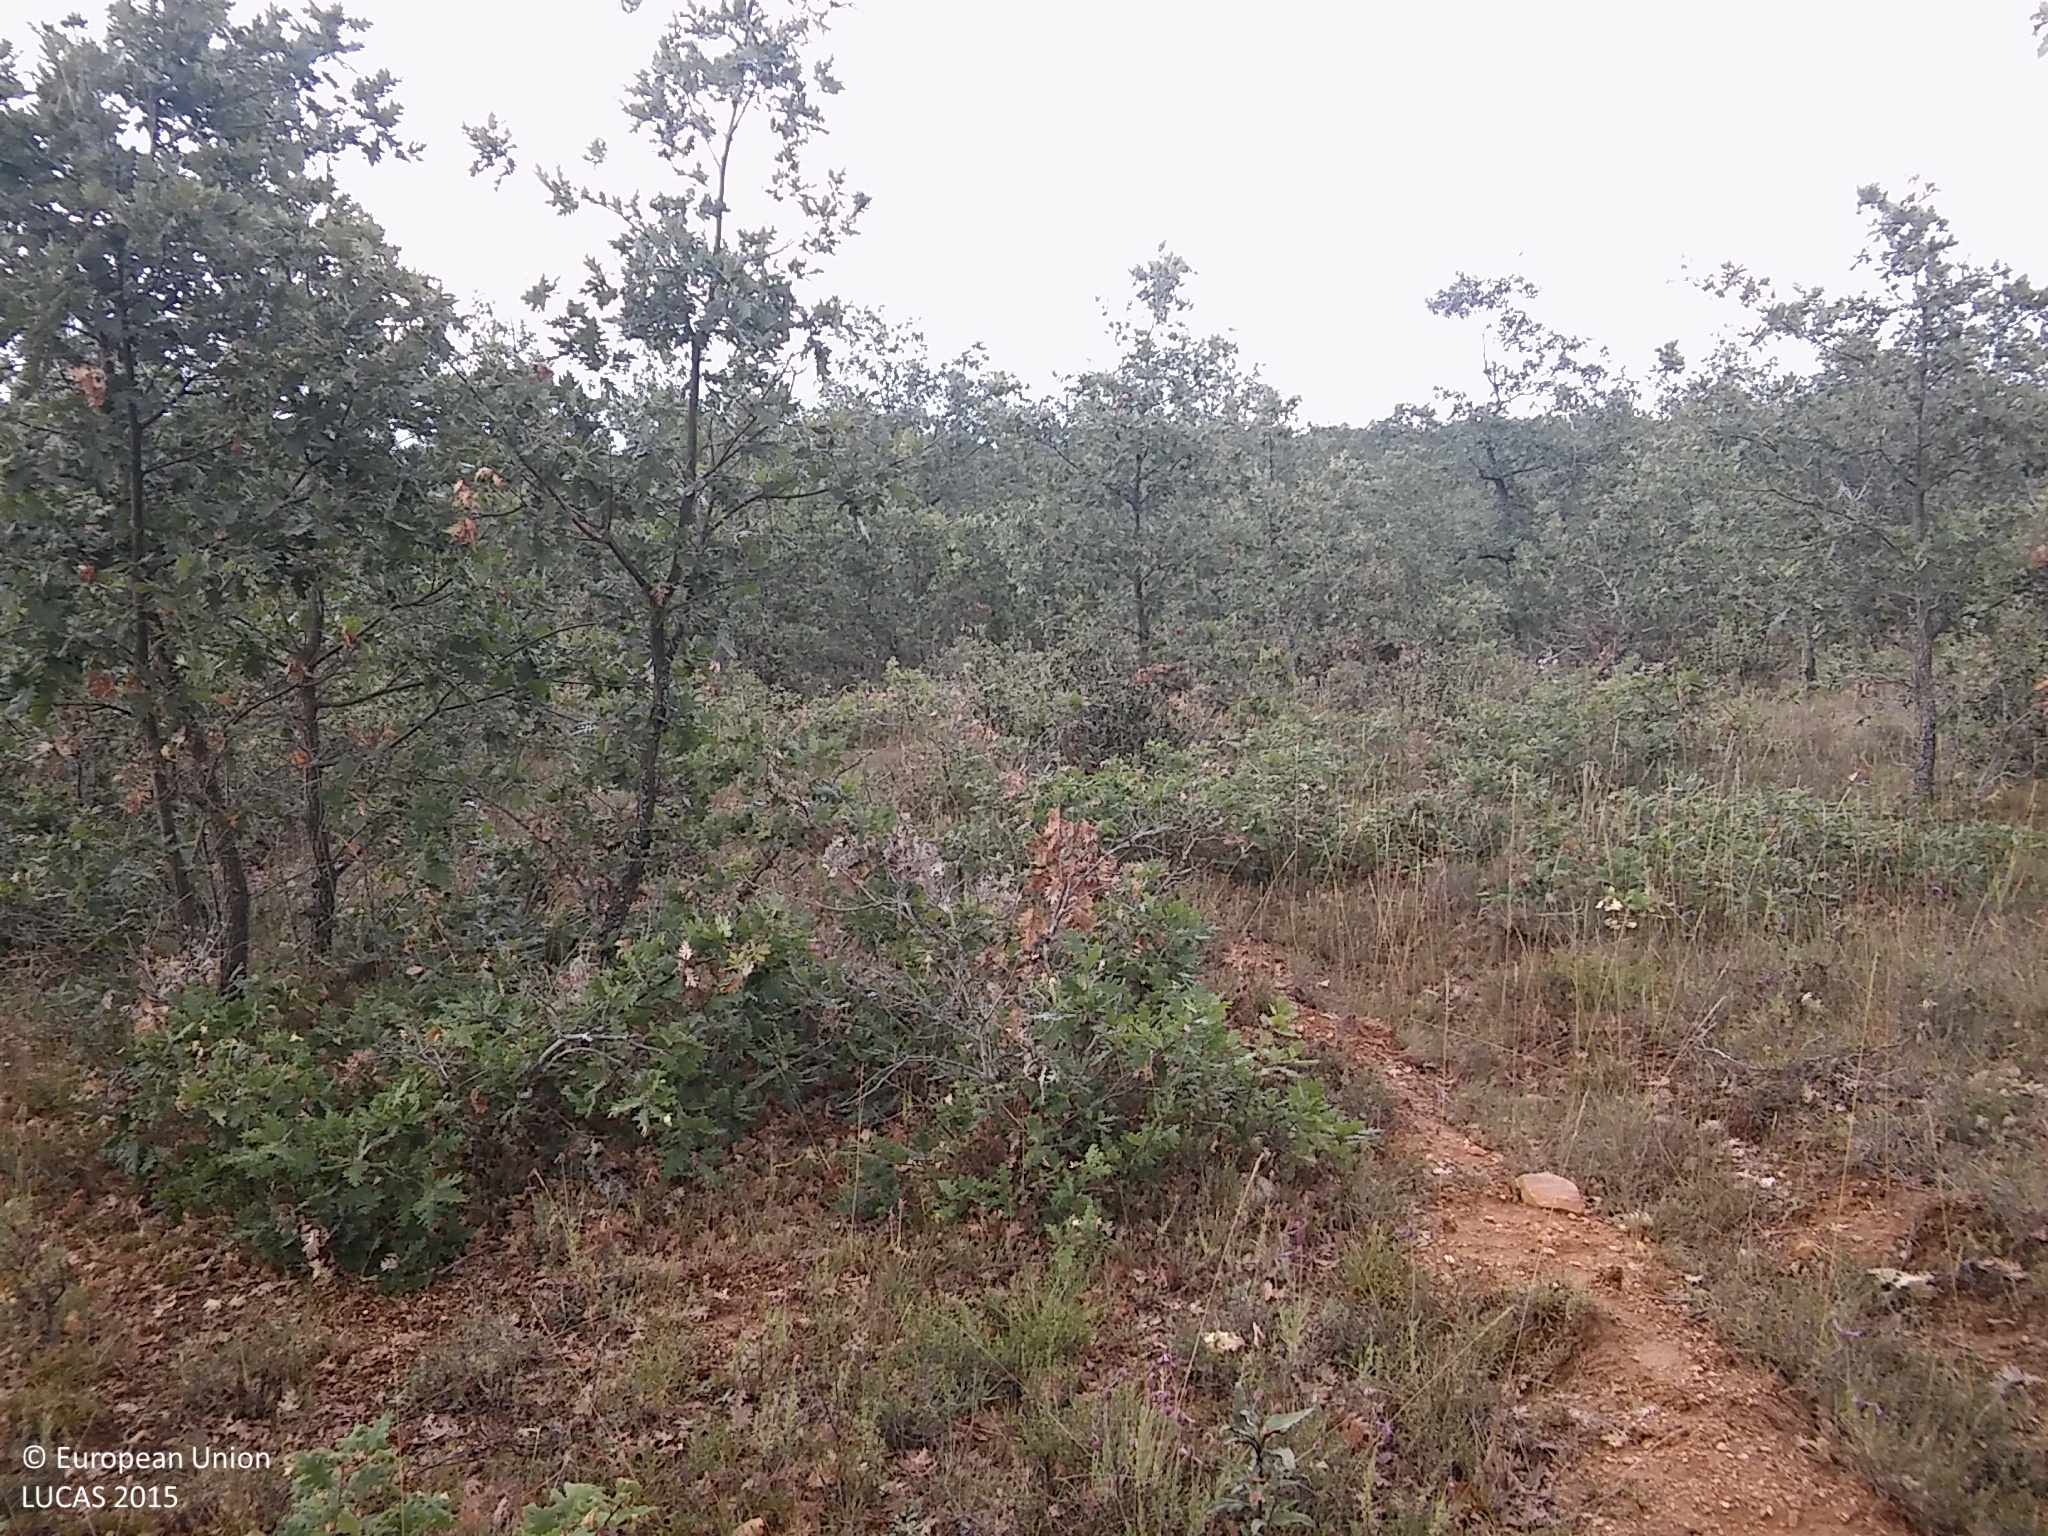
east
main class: Woodland
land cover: Broadleaved woodland
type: acidophilous oak and oak-birch forest
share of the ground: 10 - 25 %
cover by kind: shrubs 50 %, broadleaved forest trees 20 %, lichens and mosses 20 %, herbaceous plants 10 %
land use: Forestry
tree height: > 5 m
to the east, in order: Broadleaved woodland; Grass margins; Tracks; Shrubland without tree cover; Ditches and canals; Grassland without tree/shrub cover; Broadleaved woodland; Rivers and streams
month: June
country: ES
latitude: 41.4684
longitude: -3.7856
